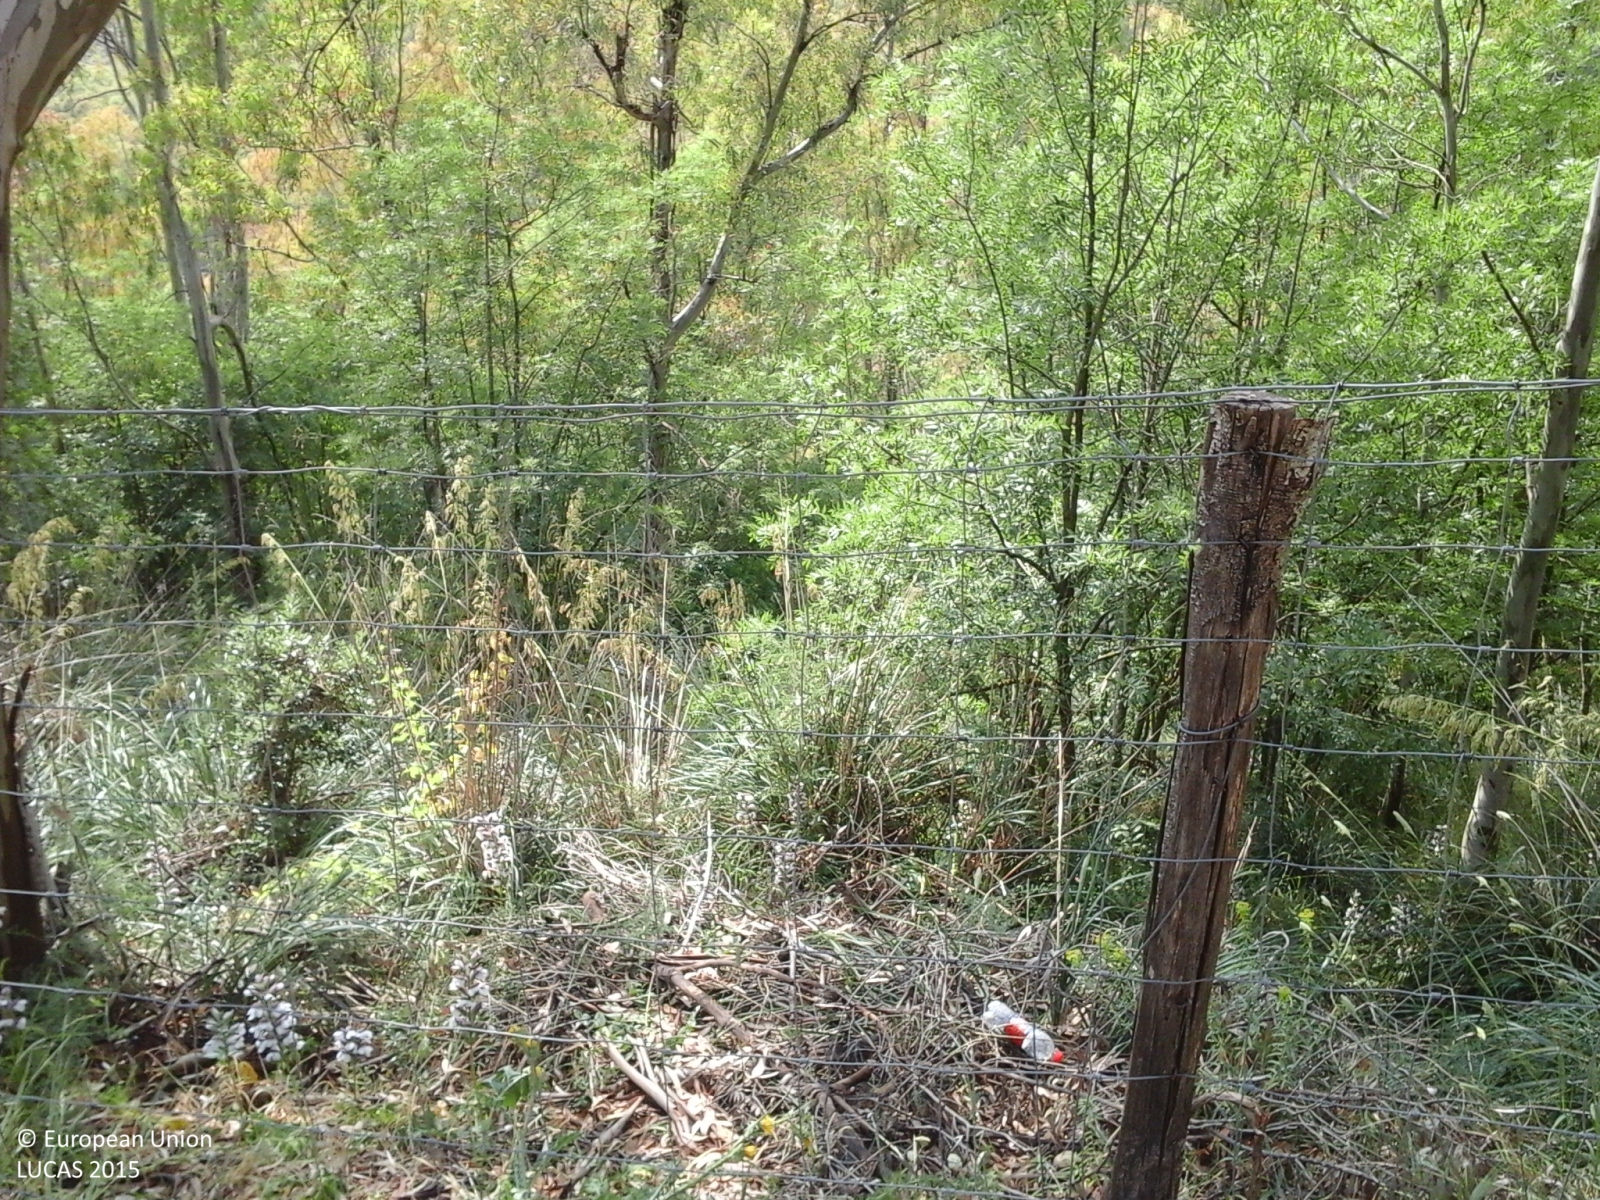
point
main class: Woodland
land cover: Broadleaved woodland
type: thermophilous deciduous forest
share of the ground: > 75 %
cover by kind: broadleaved forest trees 70 %, shrubs 20 %, herbaceous plants 10 %
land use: Forestry
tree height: > 5 m
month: June
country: IT
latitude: 37.2629
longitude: 14.4202
